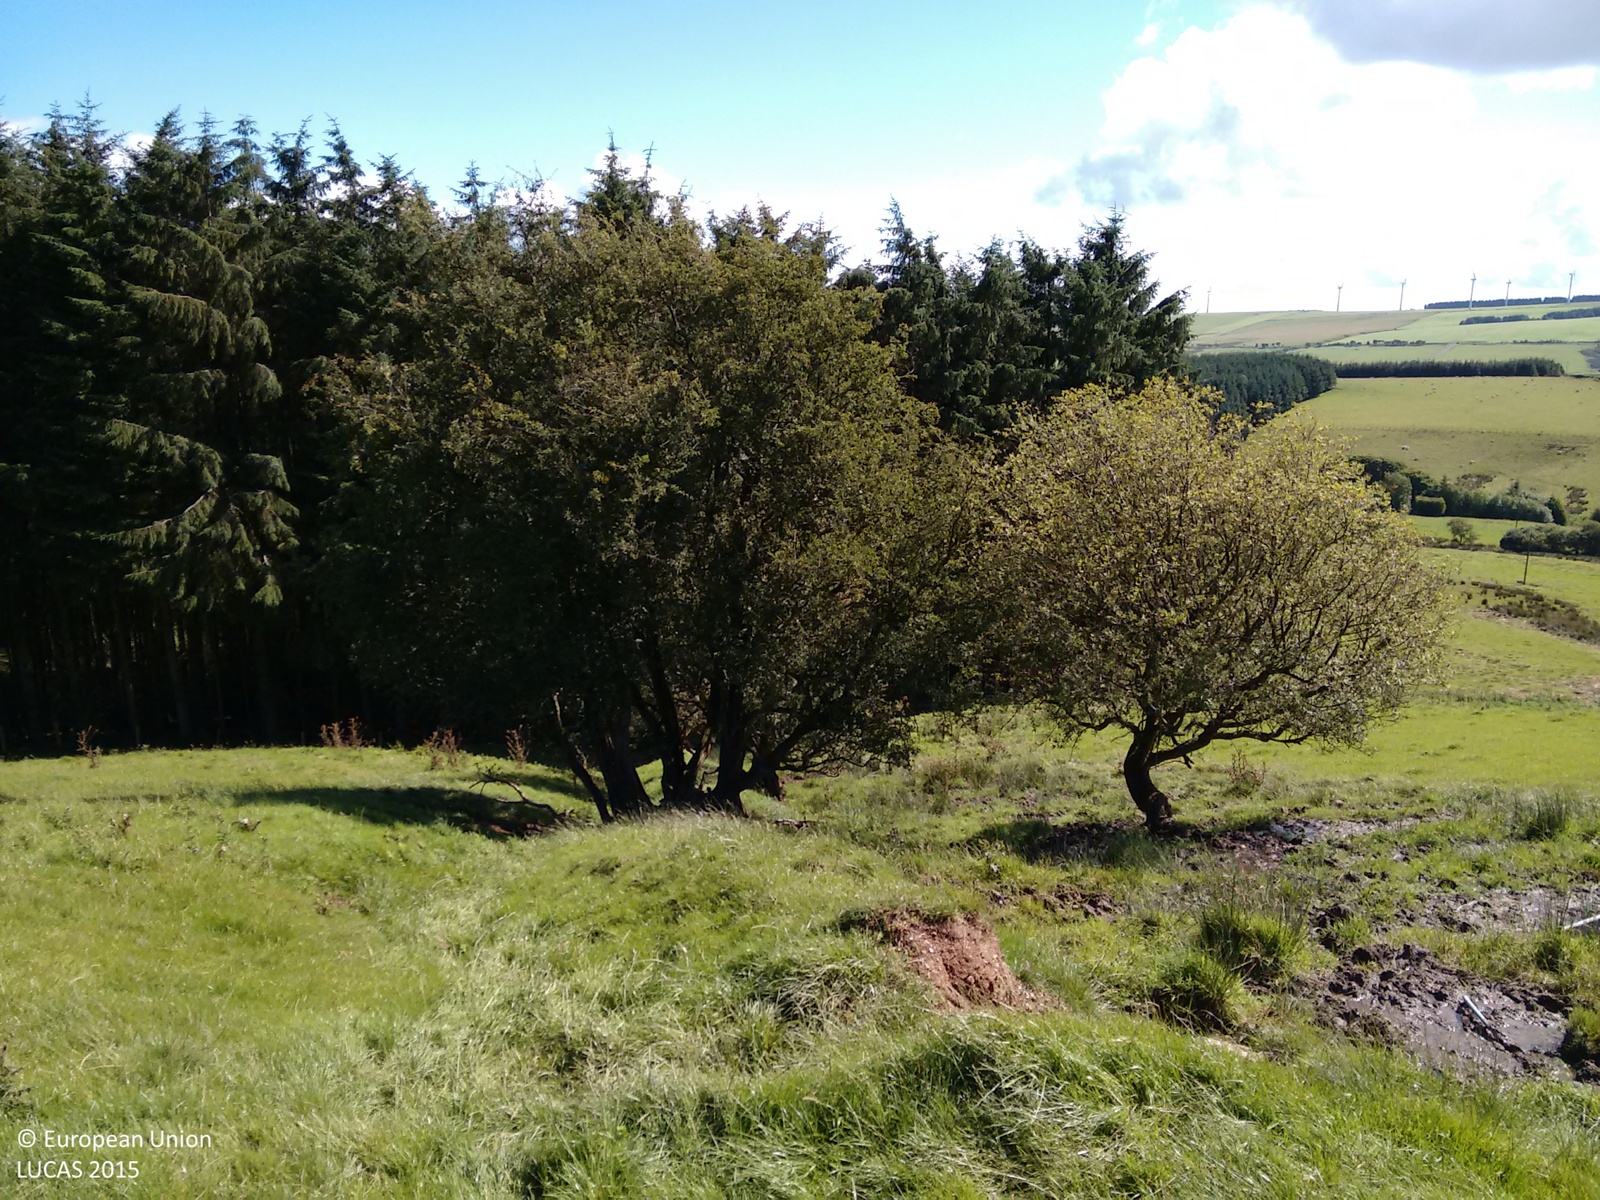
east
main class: Grassland
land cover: Grassland without tree/shrub cover
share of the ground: > 75 %
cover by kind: herbaceous plants 100 %
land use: Agriculture (excluding fallow land and kitchen gardens)
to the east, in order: Grassland without tree/shrub cover; Broadleaved woodland; Grassland without tree/shrub cover; Tracks; Grass margins; Fences; Spruce dominated coniferous woodland; Fences; Grassland without tree/shrub cover; Electric lines; Grassland without tree/shrub cover
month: August
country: GB
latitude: 53.1315
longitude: -3.5209
